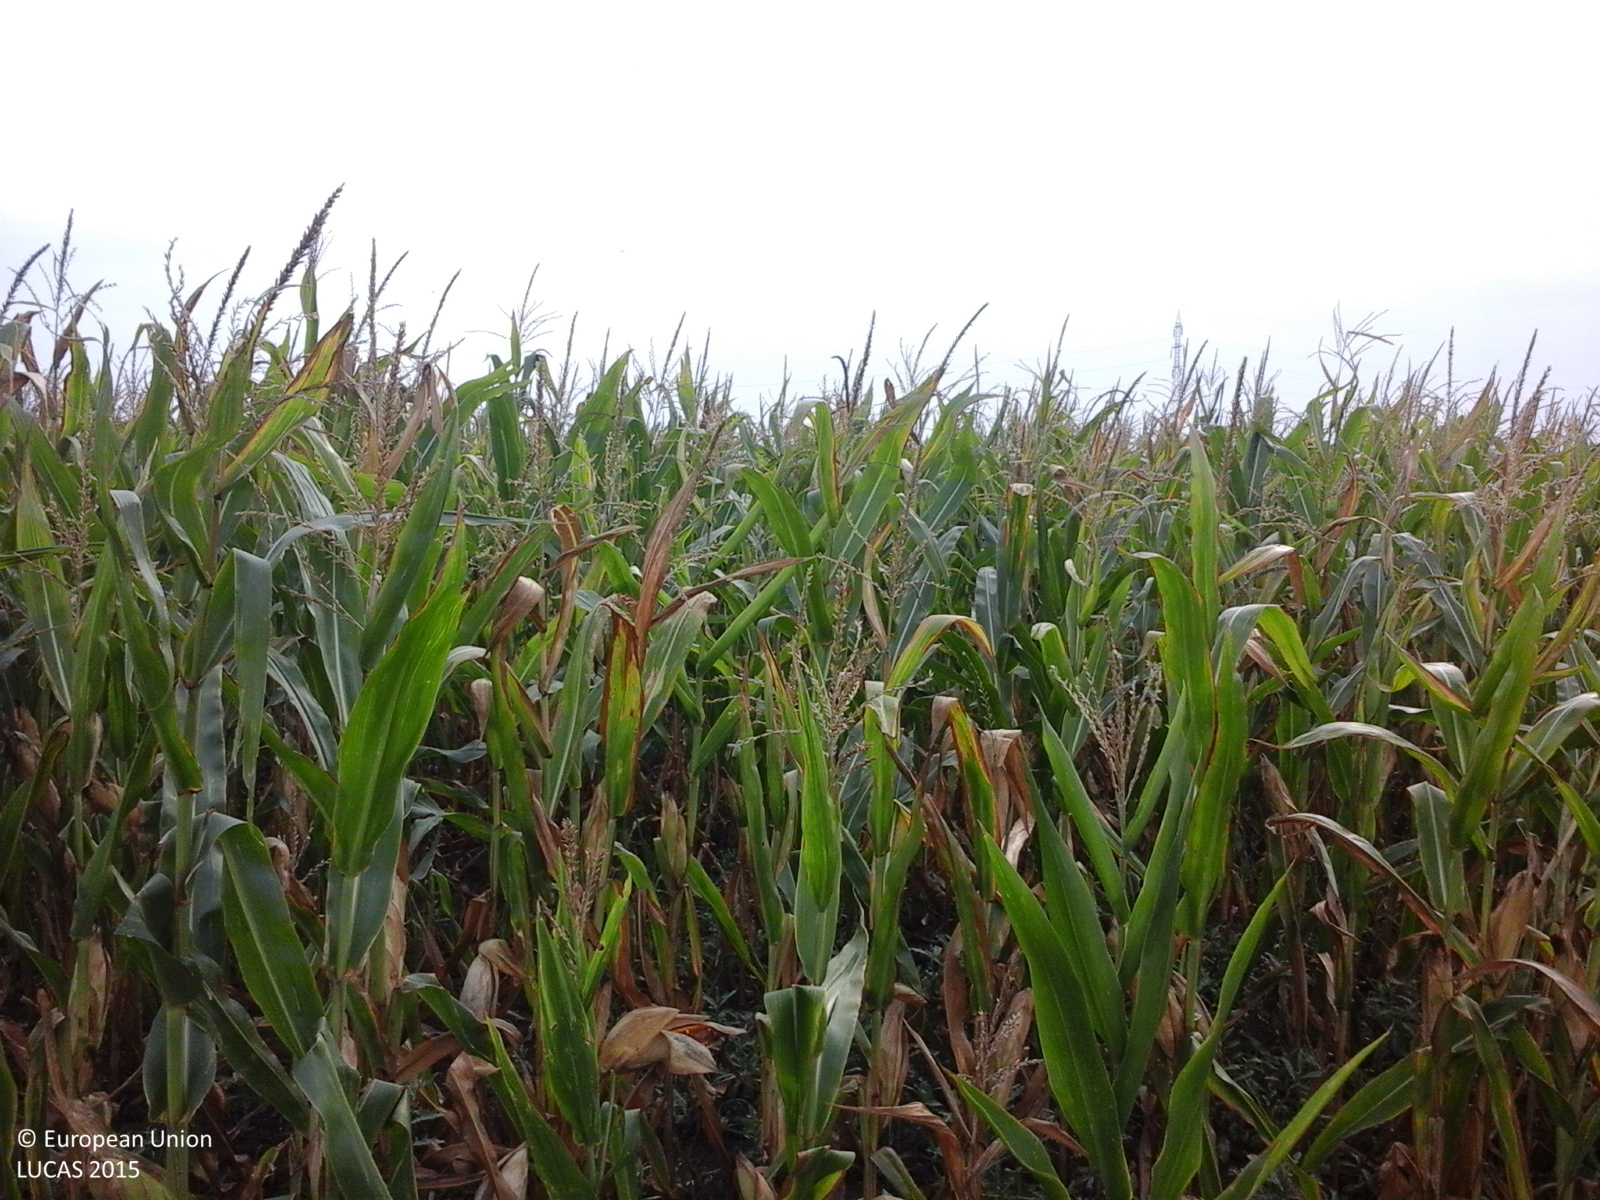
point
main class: Cropland
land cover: Maize
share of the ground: > 75 %
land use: Agriculture (excluding fallow land and kitchen gardens)
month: August
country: RO
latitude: 46.2175
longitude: 21.3515
